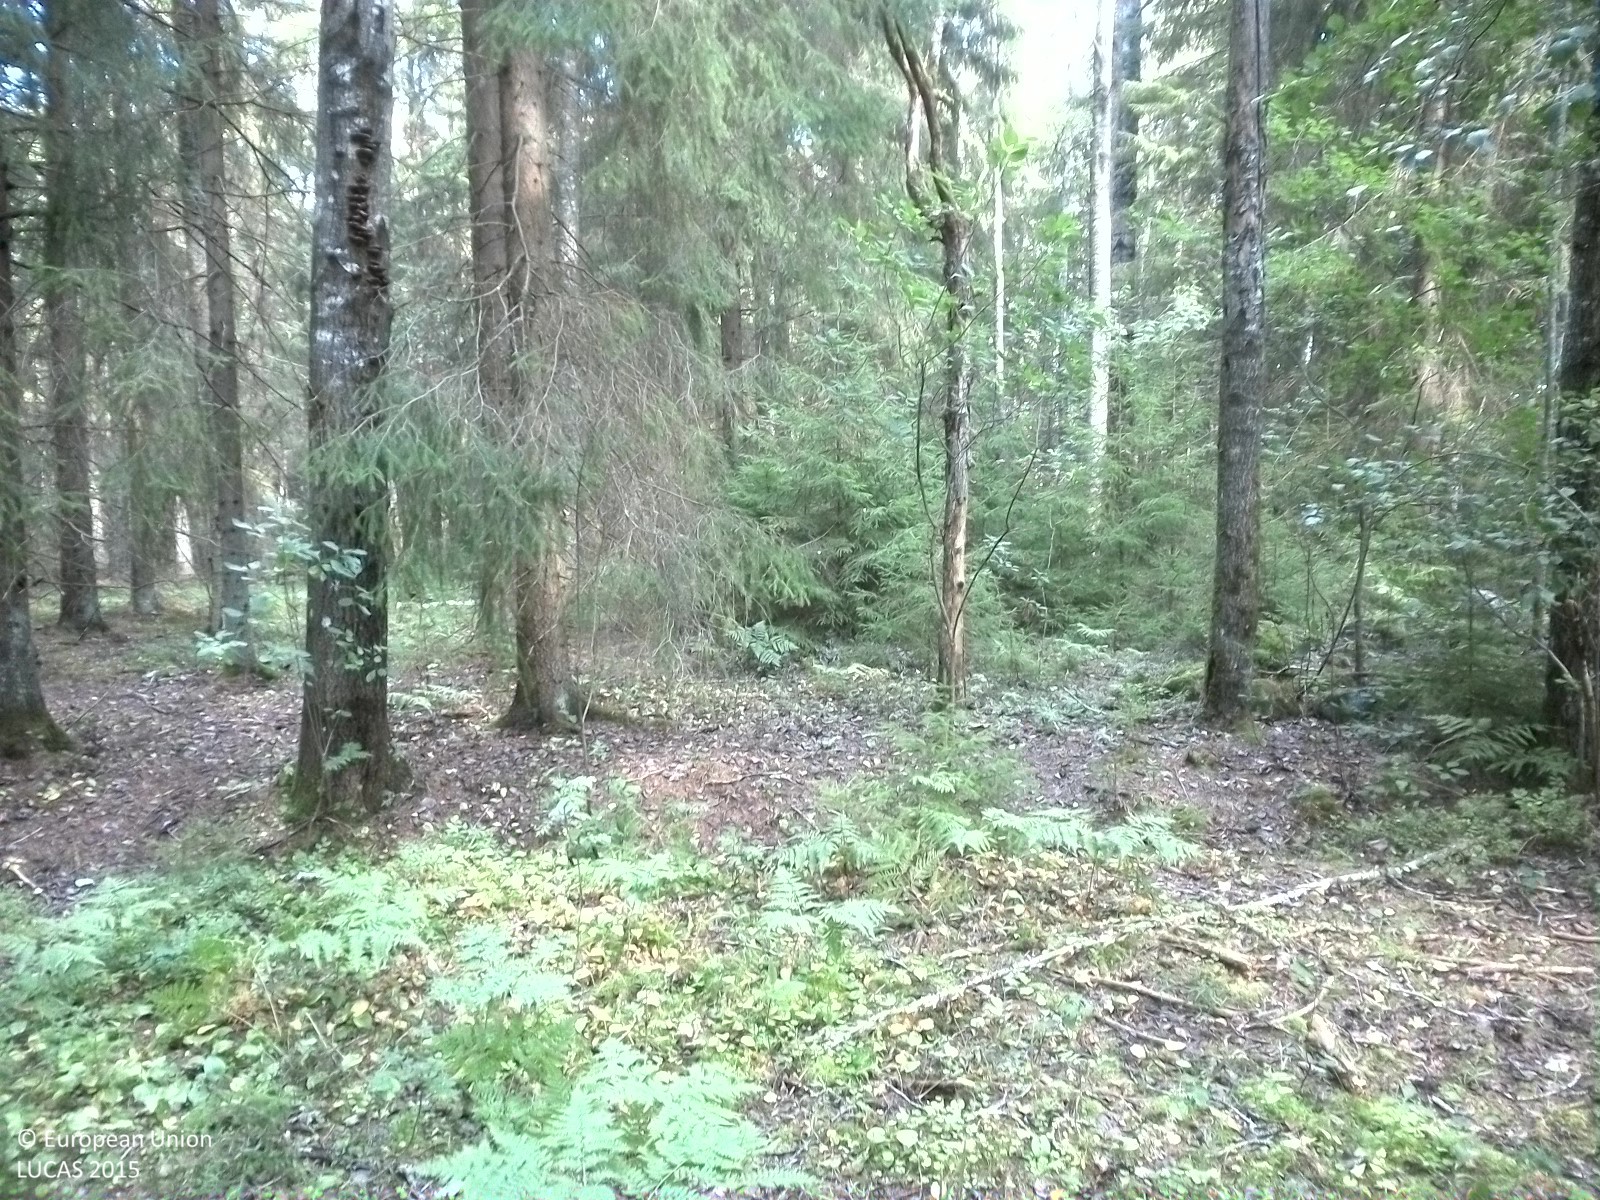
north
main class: Woodland
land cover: Spruce dominated coniferous woodland
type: boreal forest
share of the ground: 25 - 50 %
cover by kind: coniferous forest trees 40 %, lichens and mosses 30 %, herbaceous plants 25 %, broadleaved forest trees 5 %
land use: Forestry
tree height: > 5 m
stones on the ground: < 10 %
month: August
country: SE
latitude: 59.1475
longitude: 15.6392
